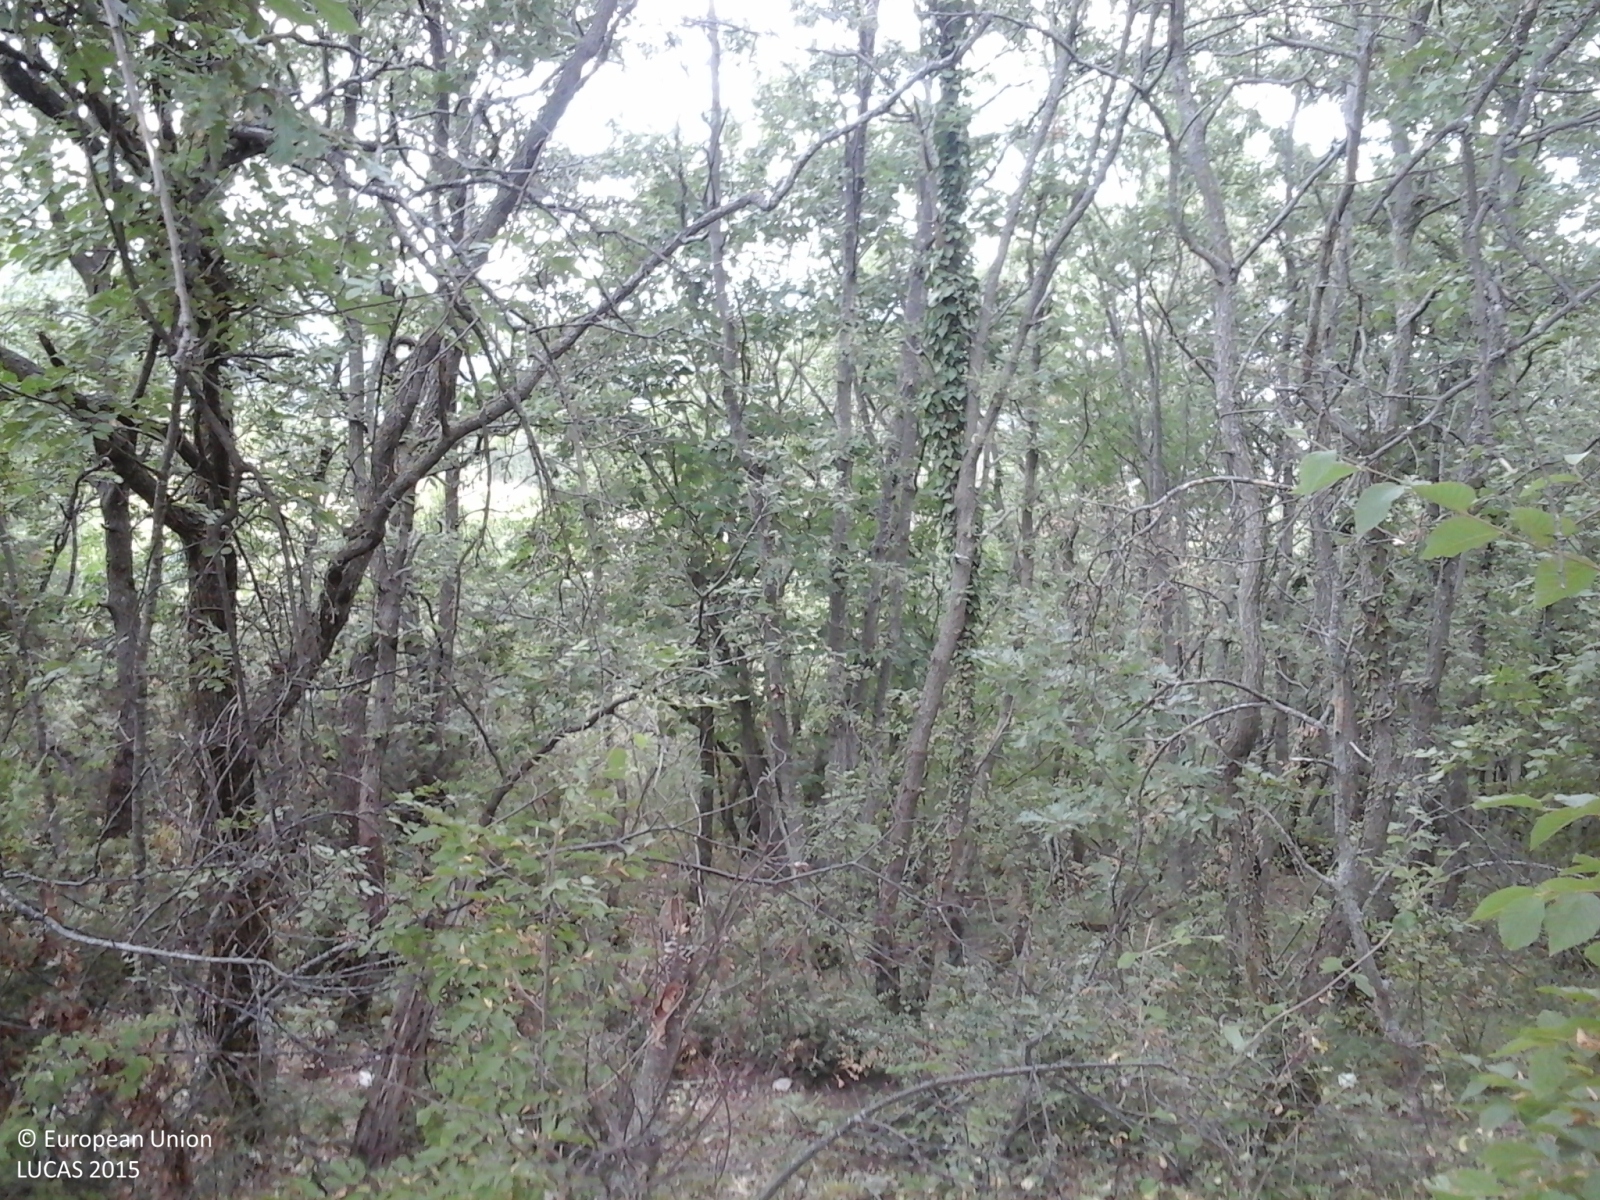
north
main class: Woodland
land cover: Broadleaved woodland
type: thermophilous deciduous forest
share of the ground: > 75 %
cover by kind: broadleaved forest trees 90 %, coniferous forest trees 5 %, herbaceous plants 5 %
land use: Forestry
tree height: > 5 m
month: July
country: IT
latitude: 43.2192
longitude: 13.1554
